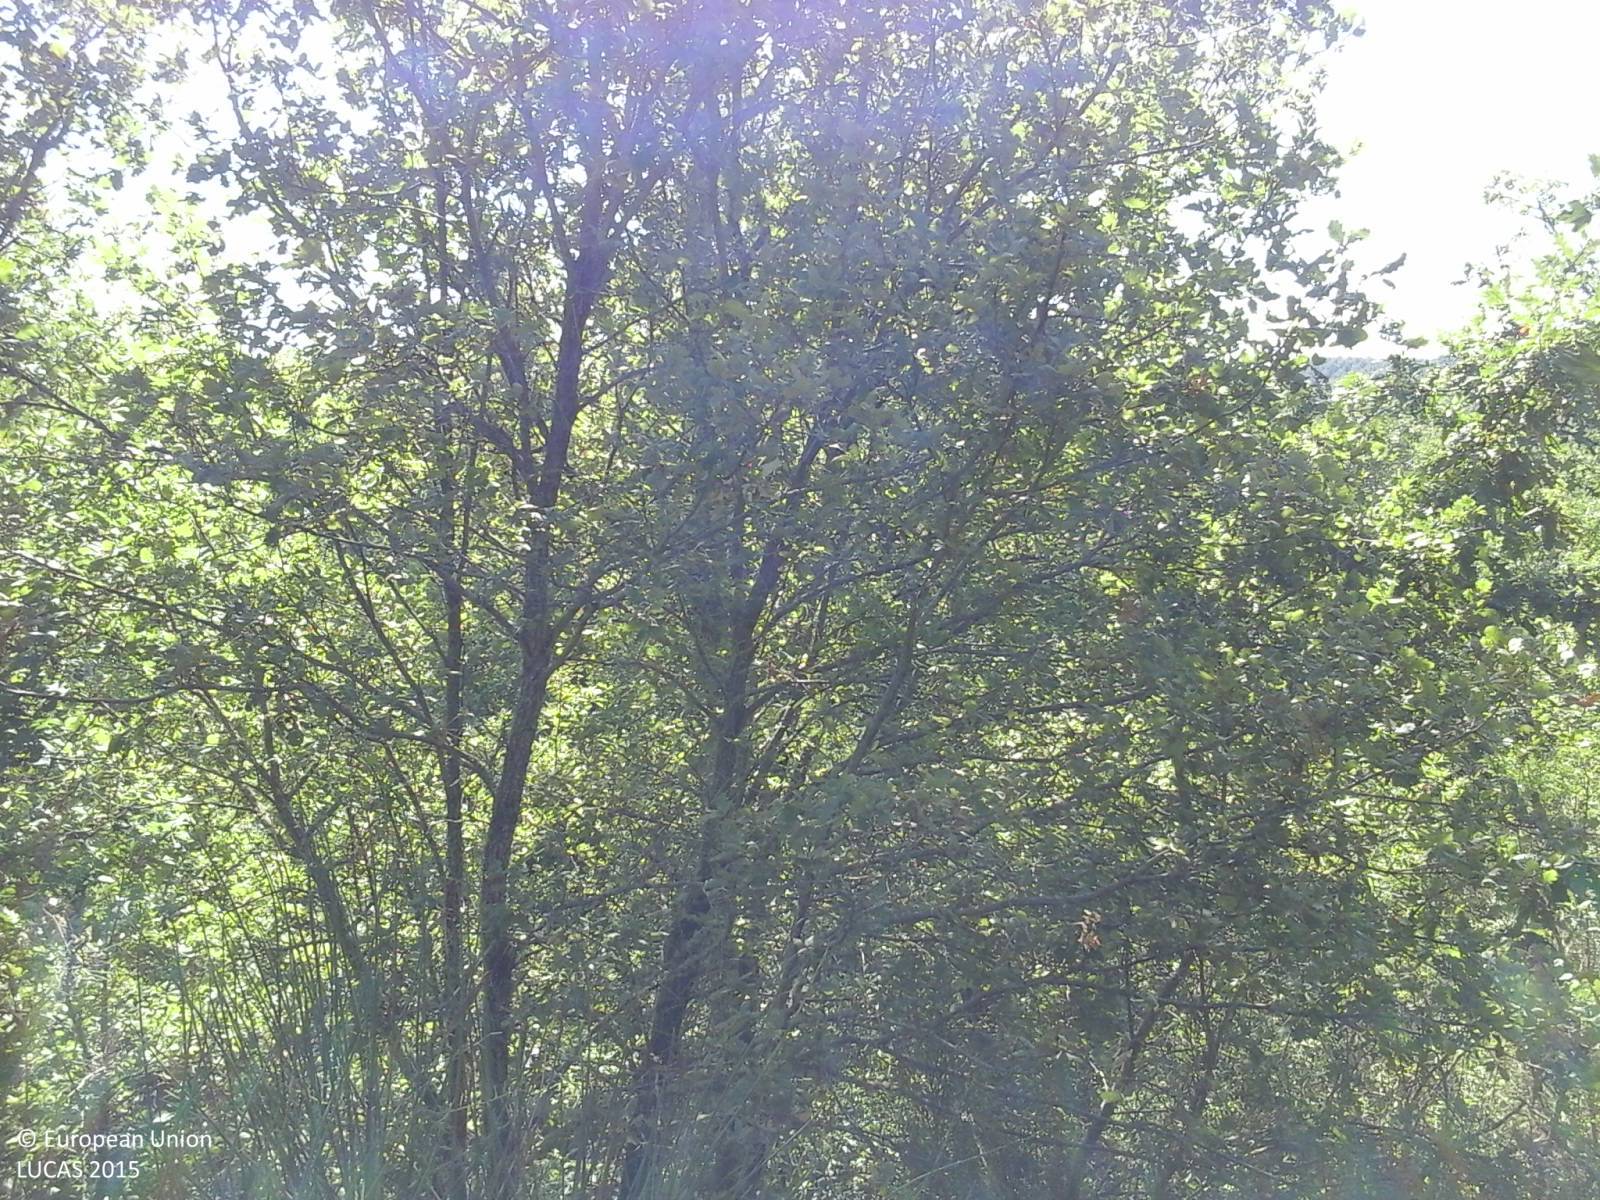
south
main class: Woodland
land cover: Broadleaved woodland
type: thermophilous deciduous forest
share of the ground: > 75 %
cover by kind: broadleaved forest trees 80 %, shrubs 20 %
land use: Forestry
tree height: < 5 m
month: September
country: IT
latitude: 42.9736
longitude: 12.1882
